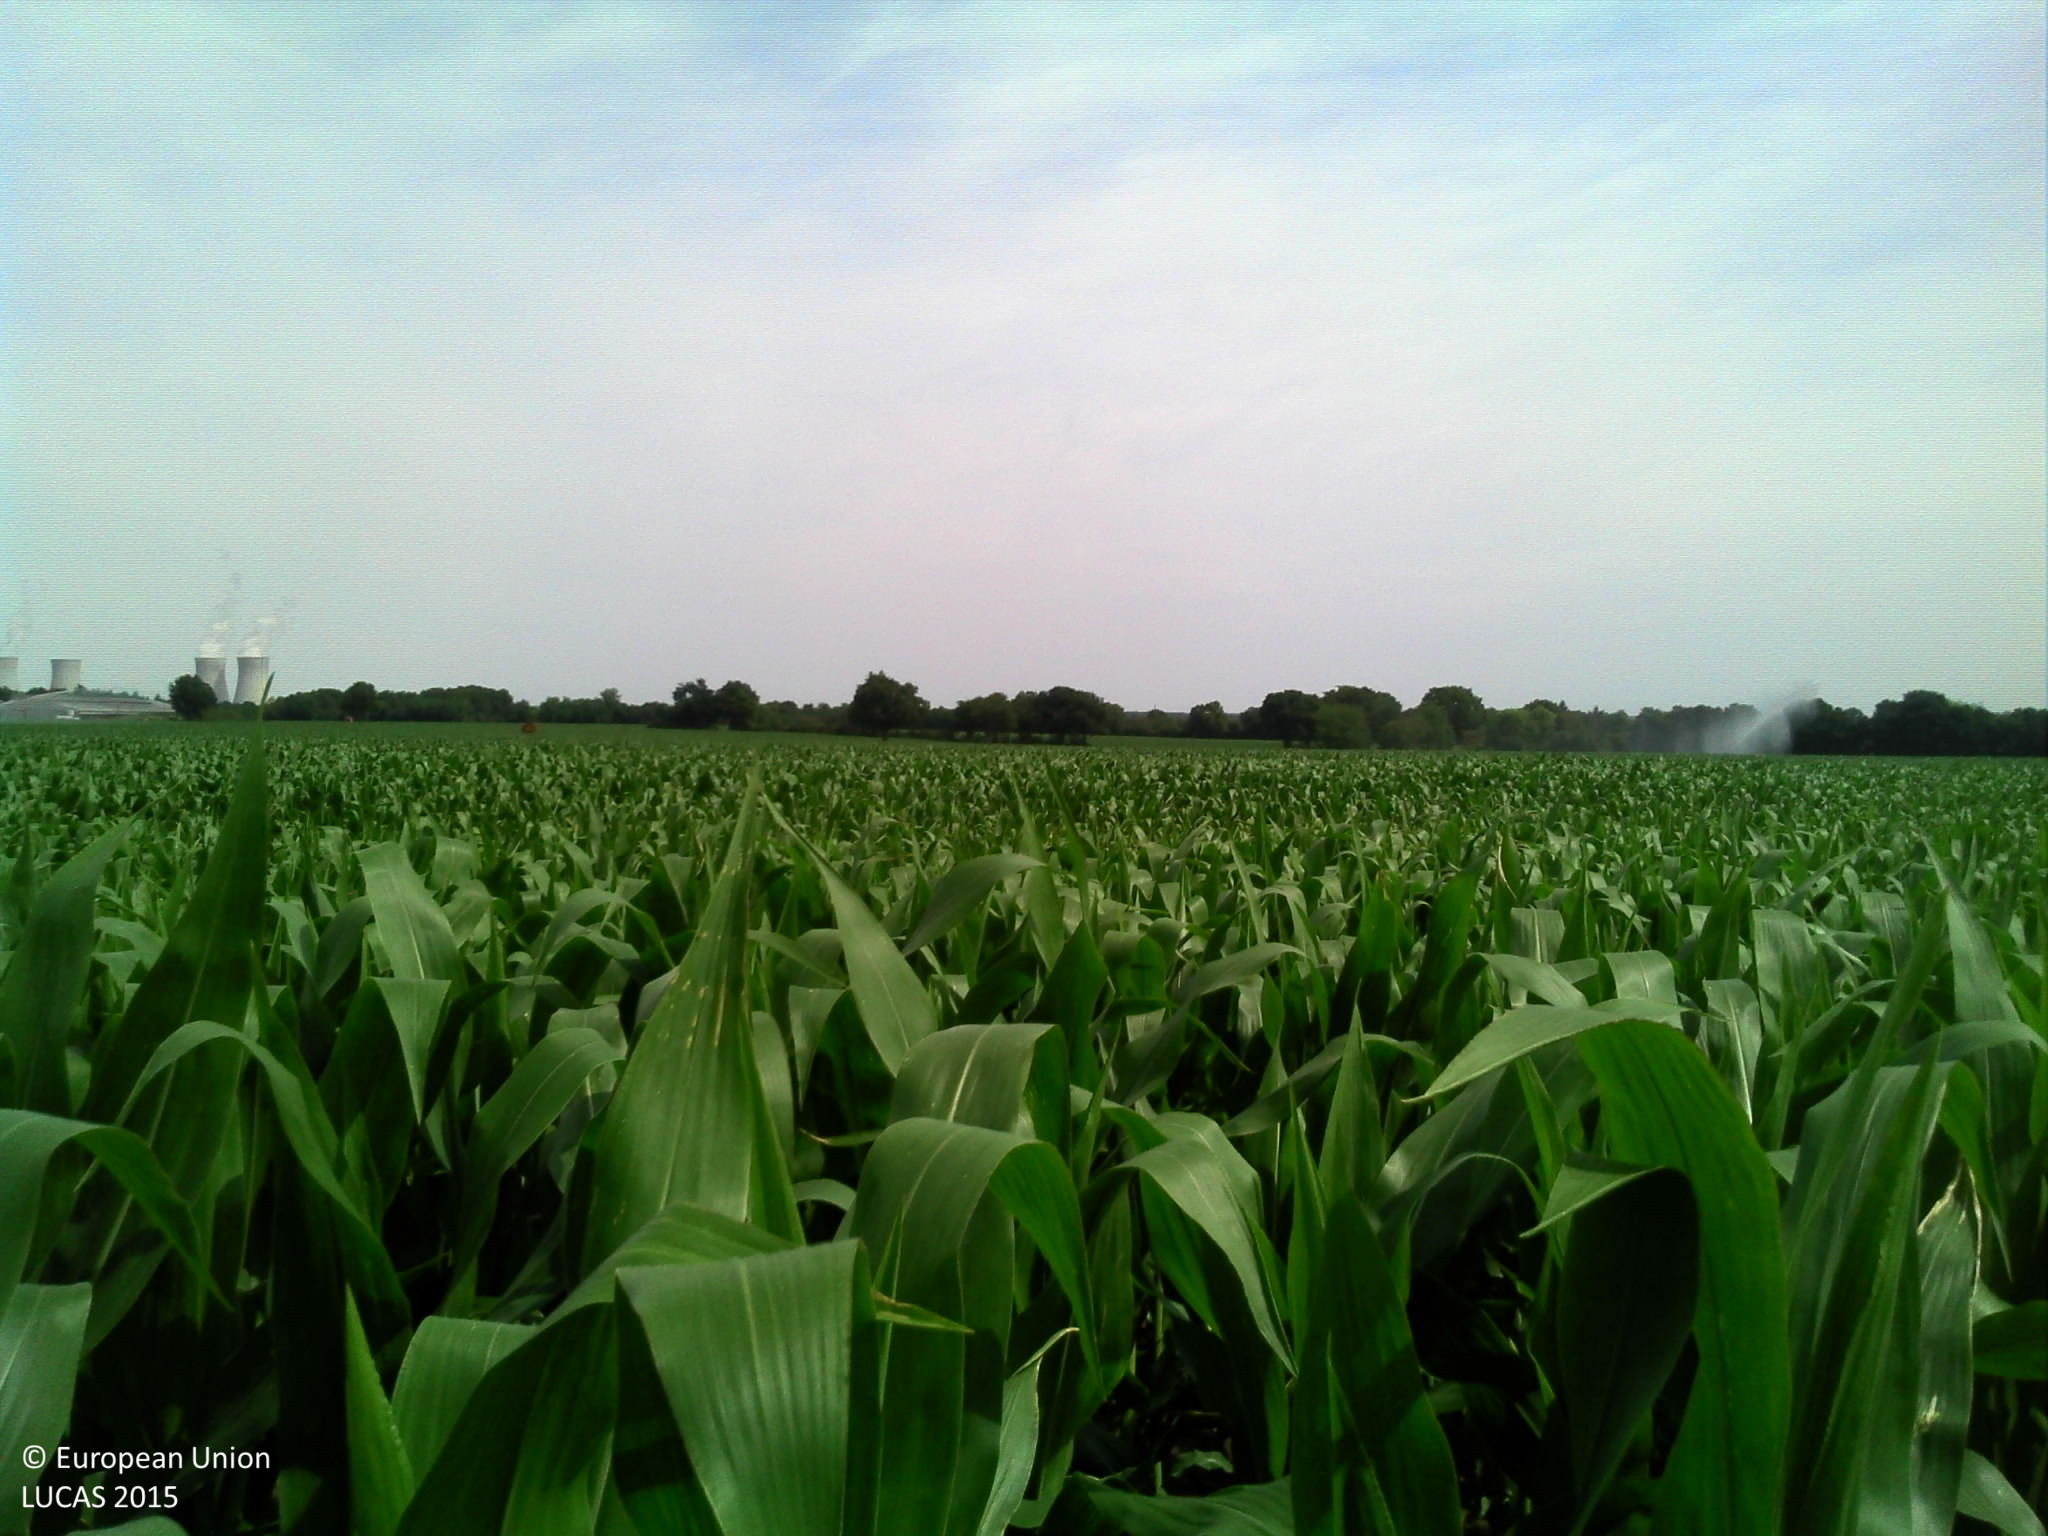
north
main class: Cropland
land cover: Maize
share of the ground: > 75 %
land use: Agriculture (excluding fallow land and kitchen gardens)
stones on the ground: 25 - 50 %
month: June
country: FR
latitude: 47.6818
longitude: 2.5451
